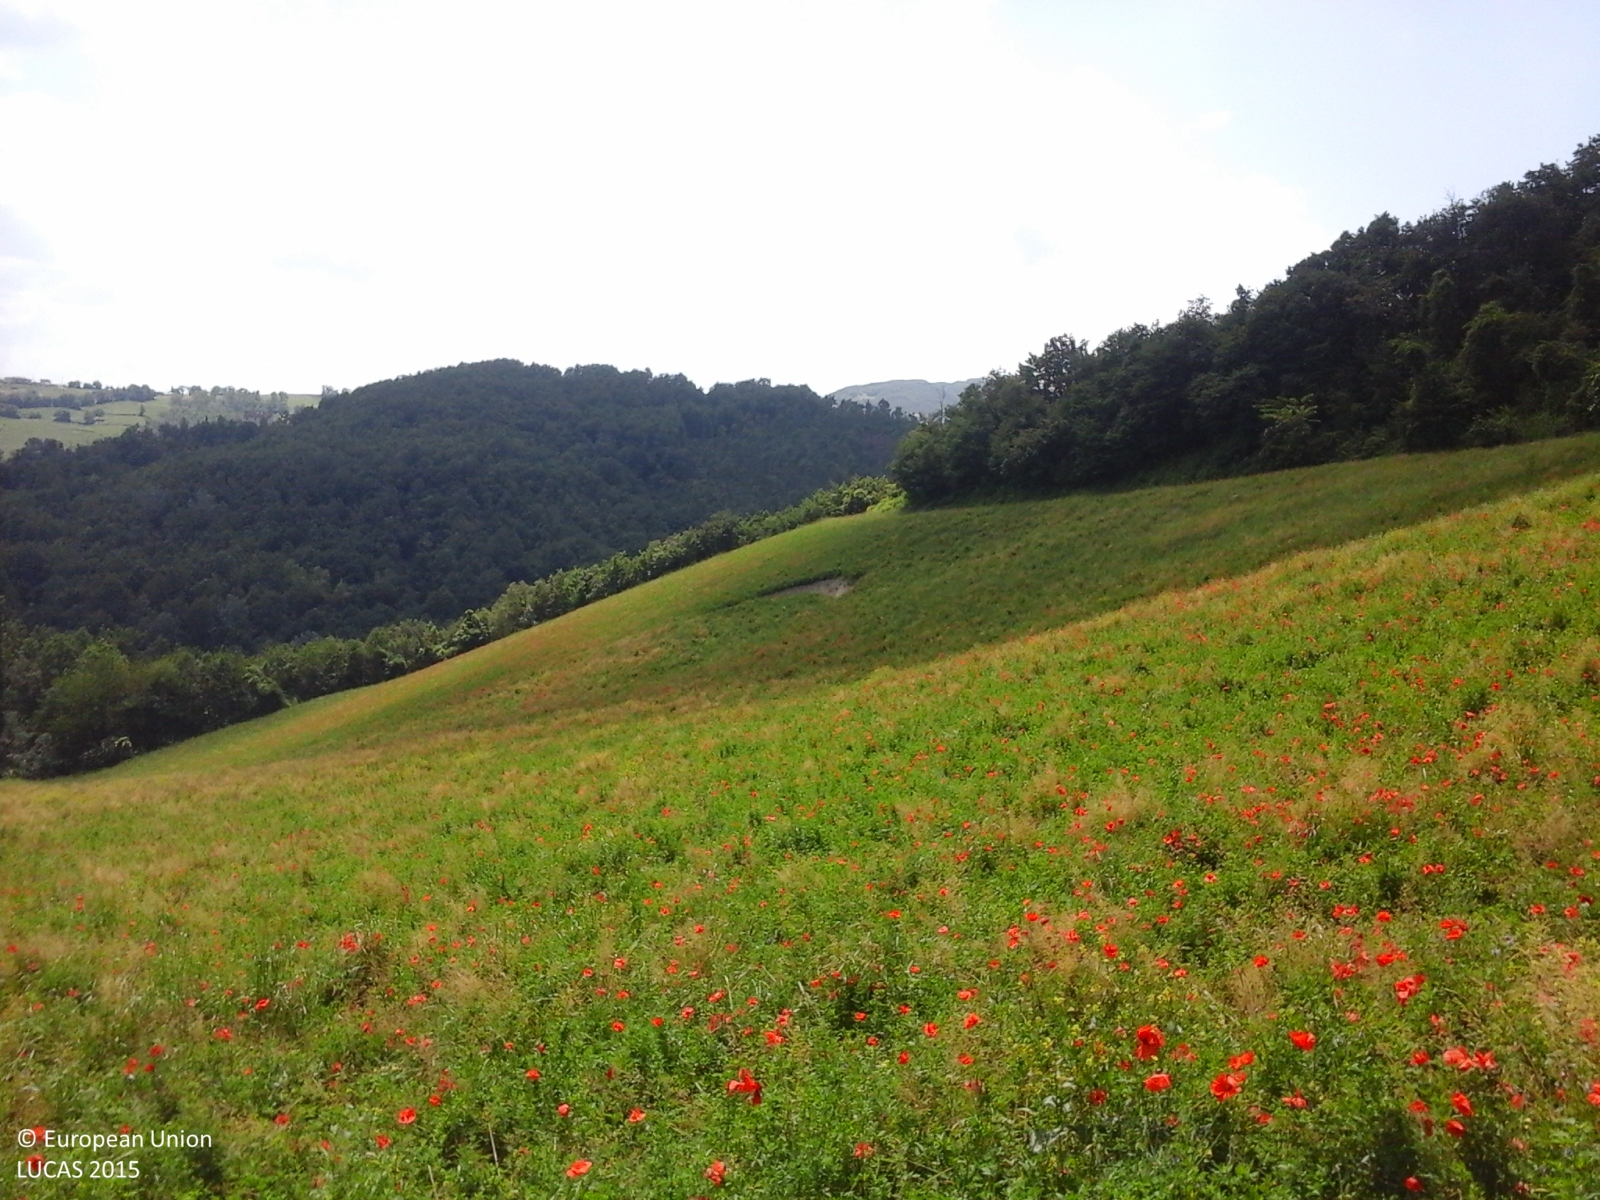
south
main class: Cropland
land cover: Lucerne
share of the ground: > 75 %
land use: Agriculture (excluding fallow land and kitchen gardens)
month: May
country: IT
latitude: 44.6569
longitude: 10.2391
